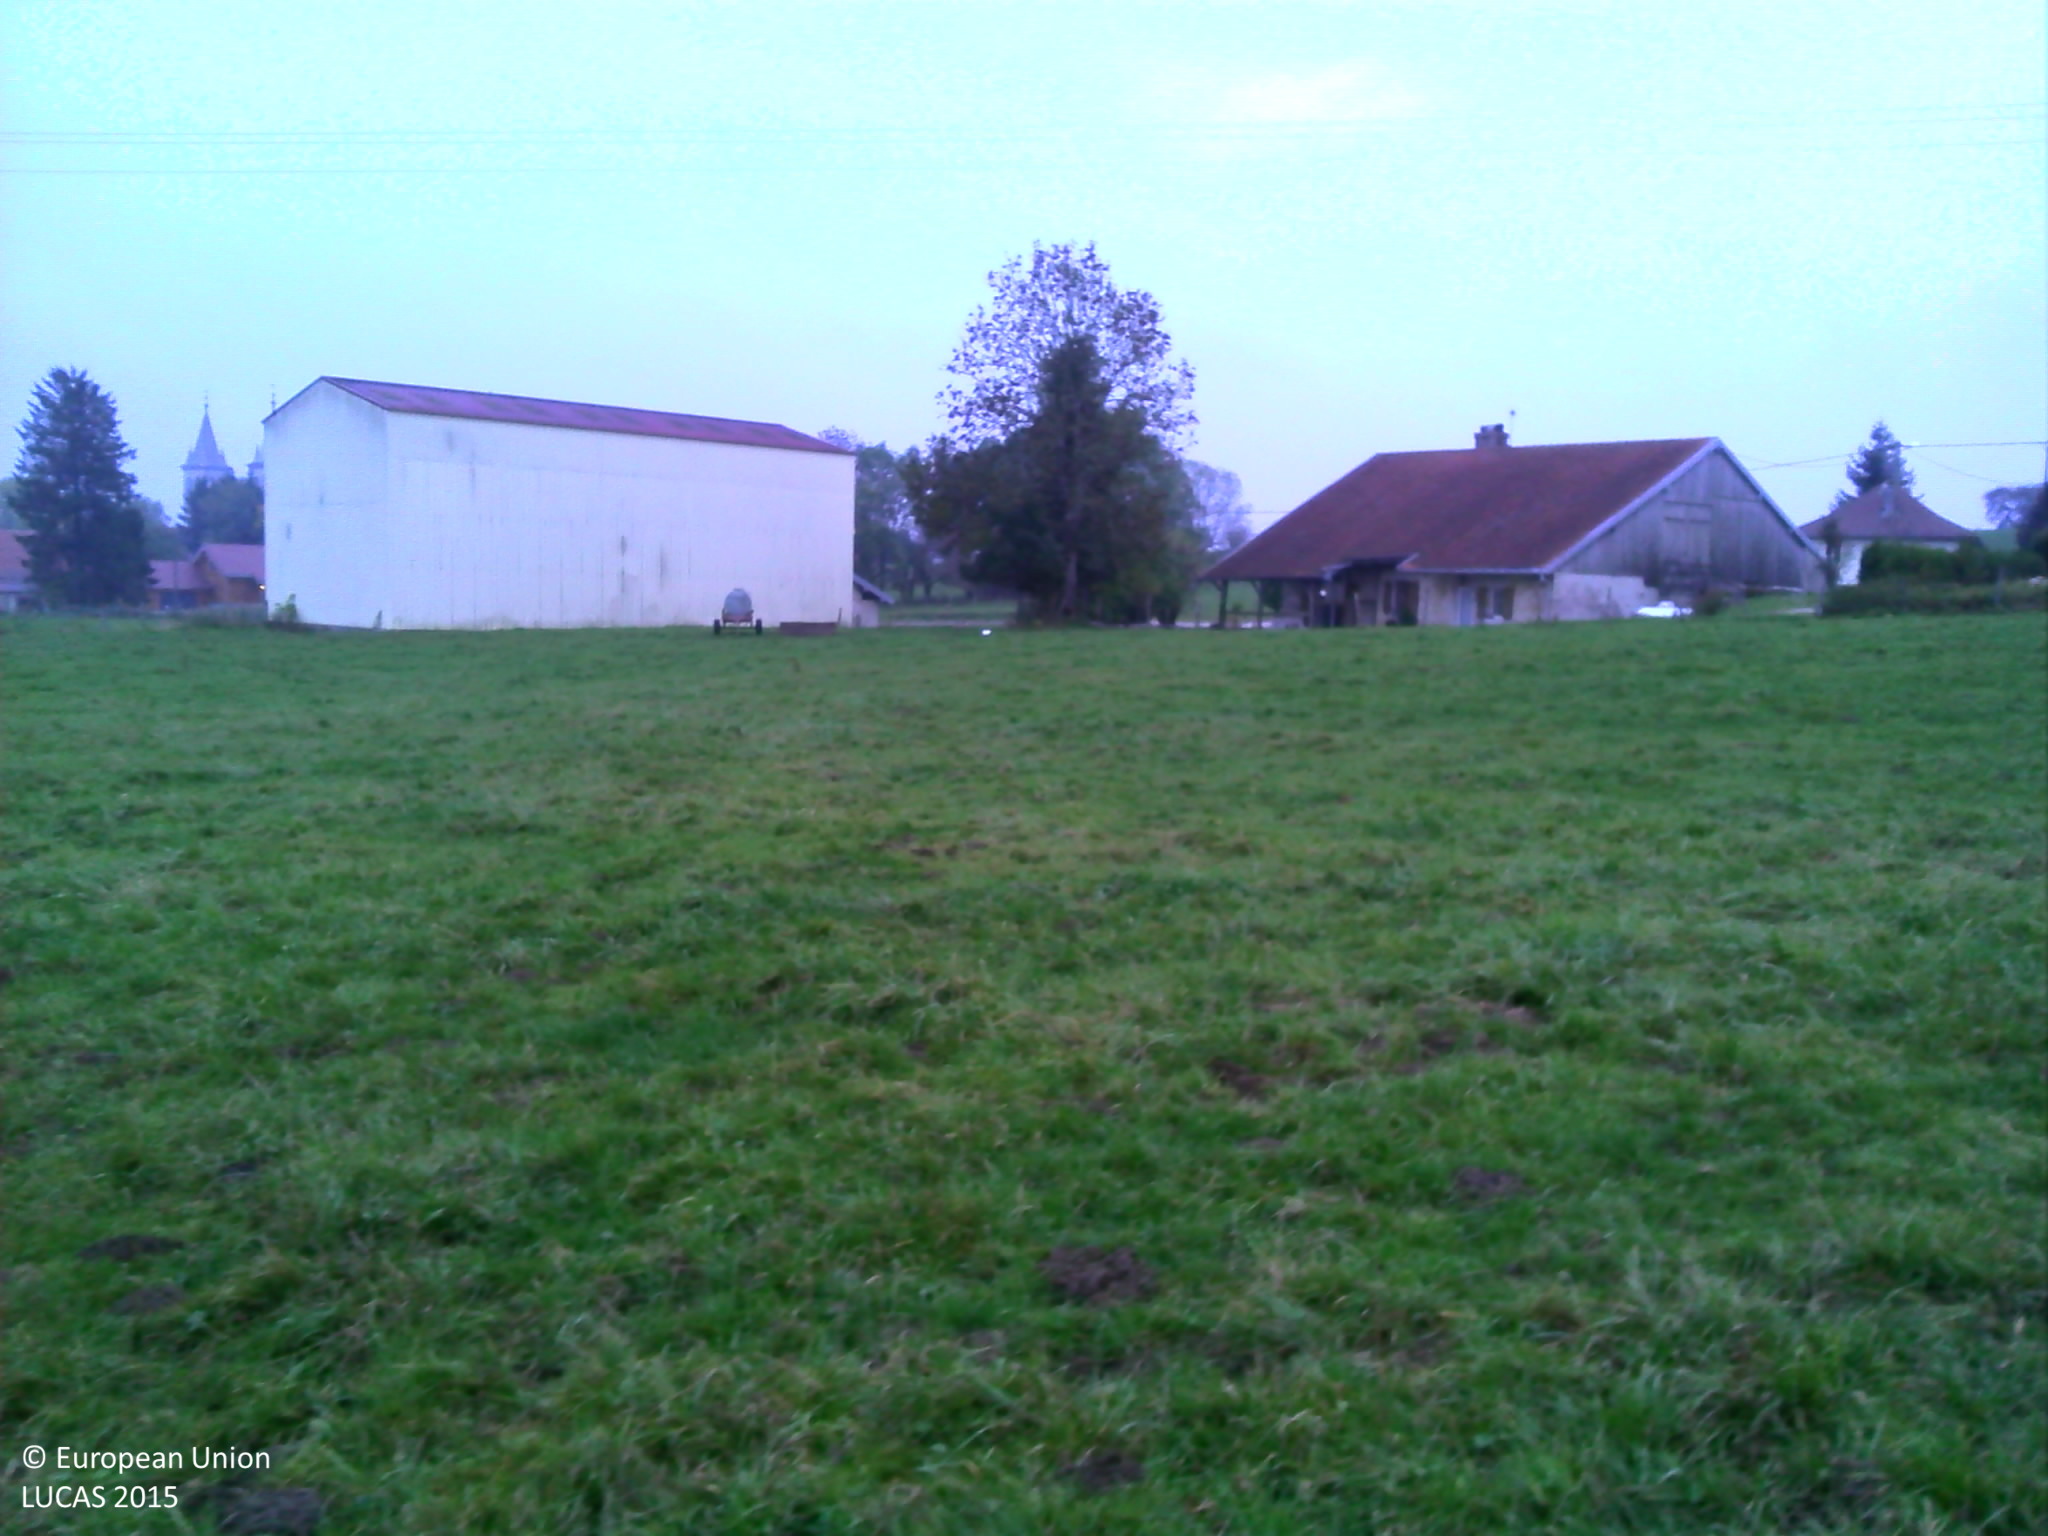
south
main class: Grassland
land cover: Grassland without tree/shrub cover
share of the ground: > 75 %
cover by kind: herbaceous plants 100 %
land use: Agriculture (excluding fallow land and kitchen gardens)
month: October
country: FR
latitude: 46.8923
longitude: 6.0780
